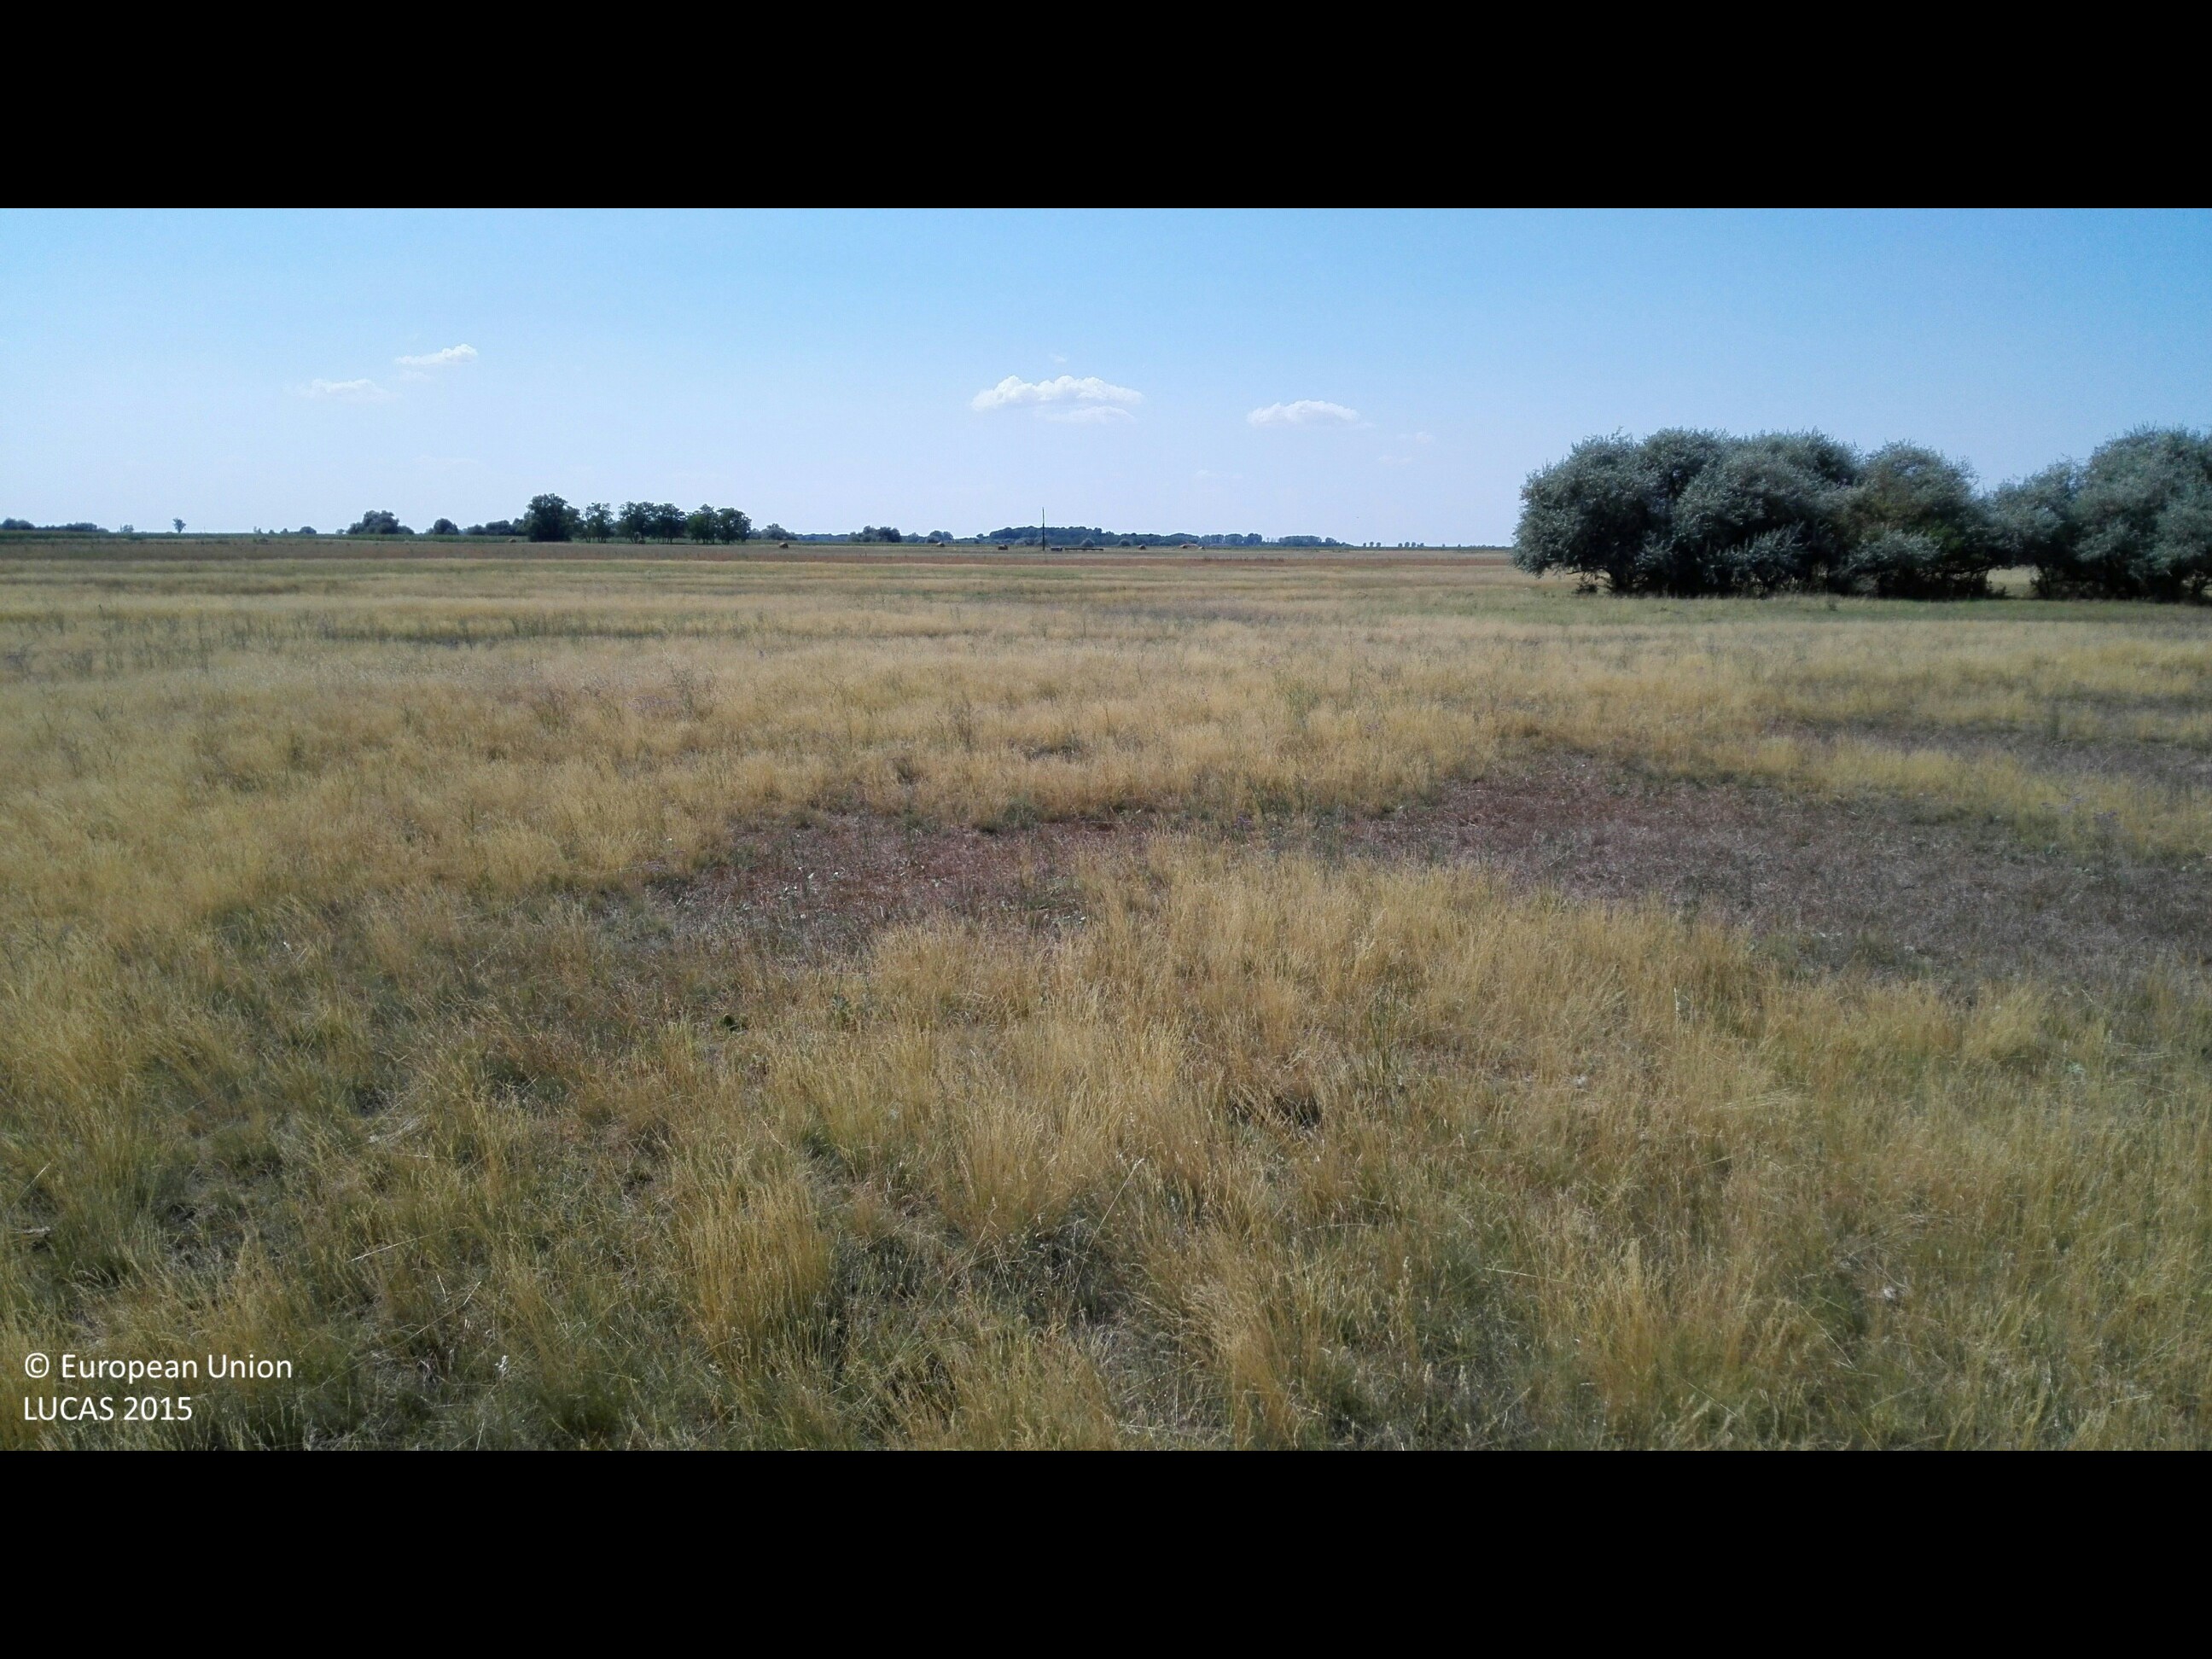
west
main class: Grassland
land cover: Grassland without tree/shrub cover
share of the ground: > 75 %
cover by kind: herbaceous plants 100 %
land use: Agriculture (excluding fallow land and kitchen gardens)
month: July
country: HU
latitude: 47.2605
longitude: 21.2852
